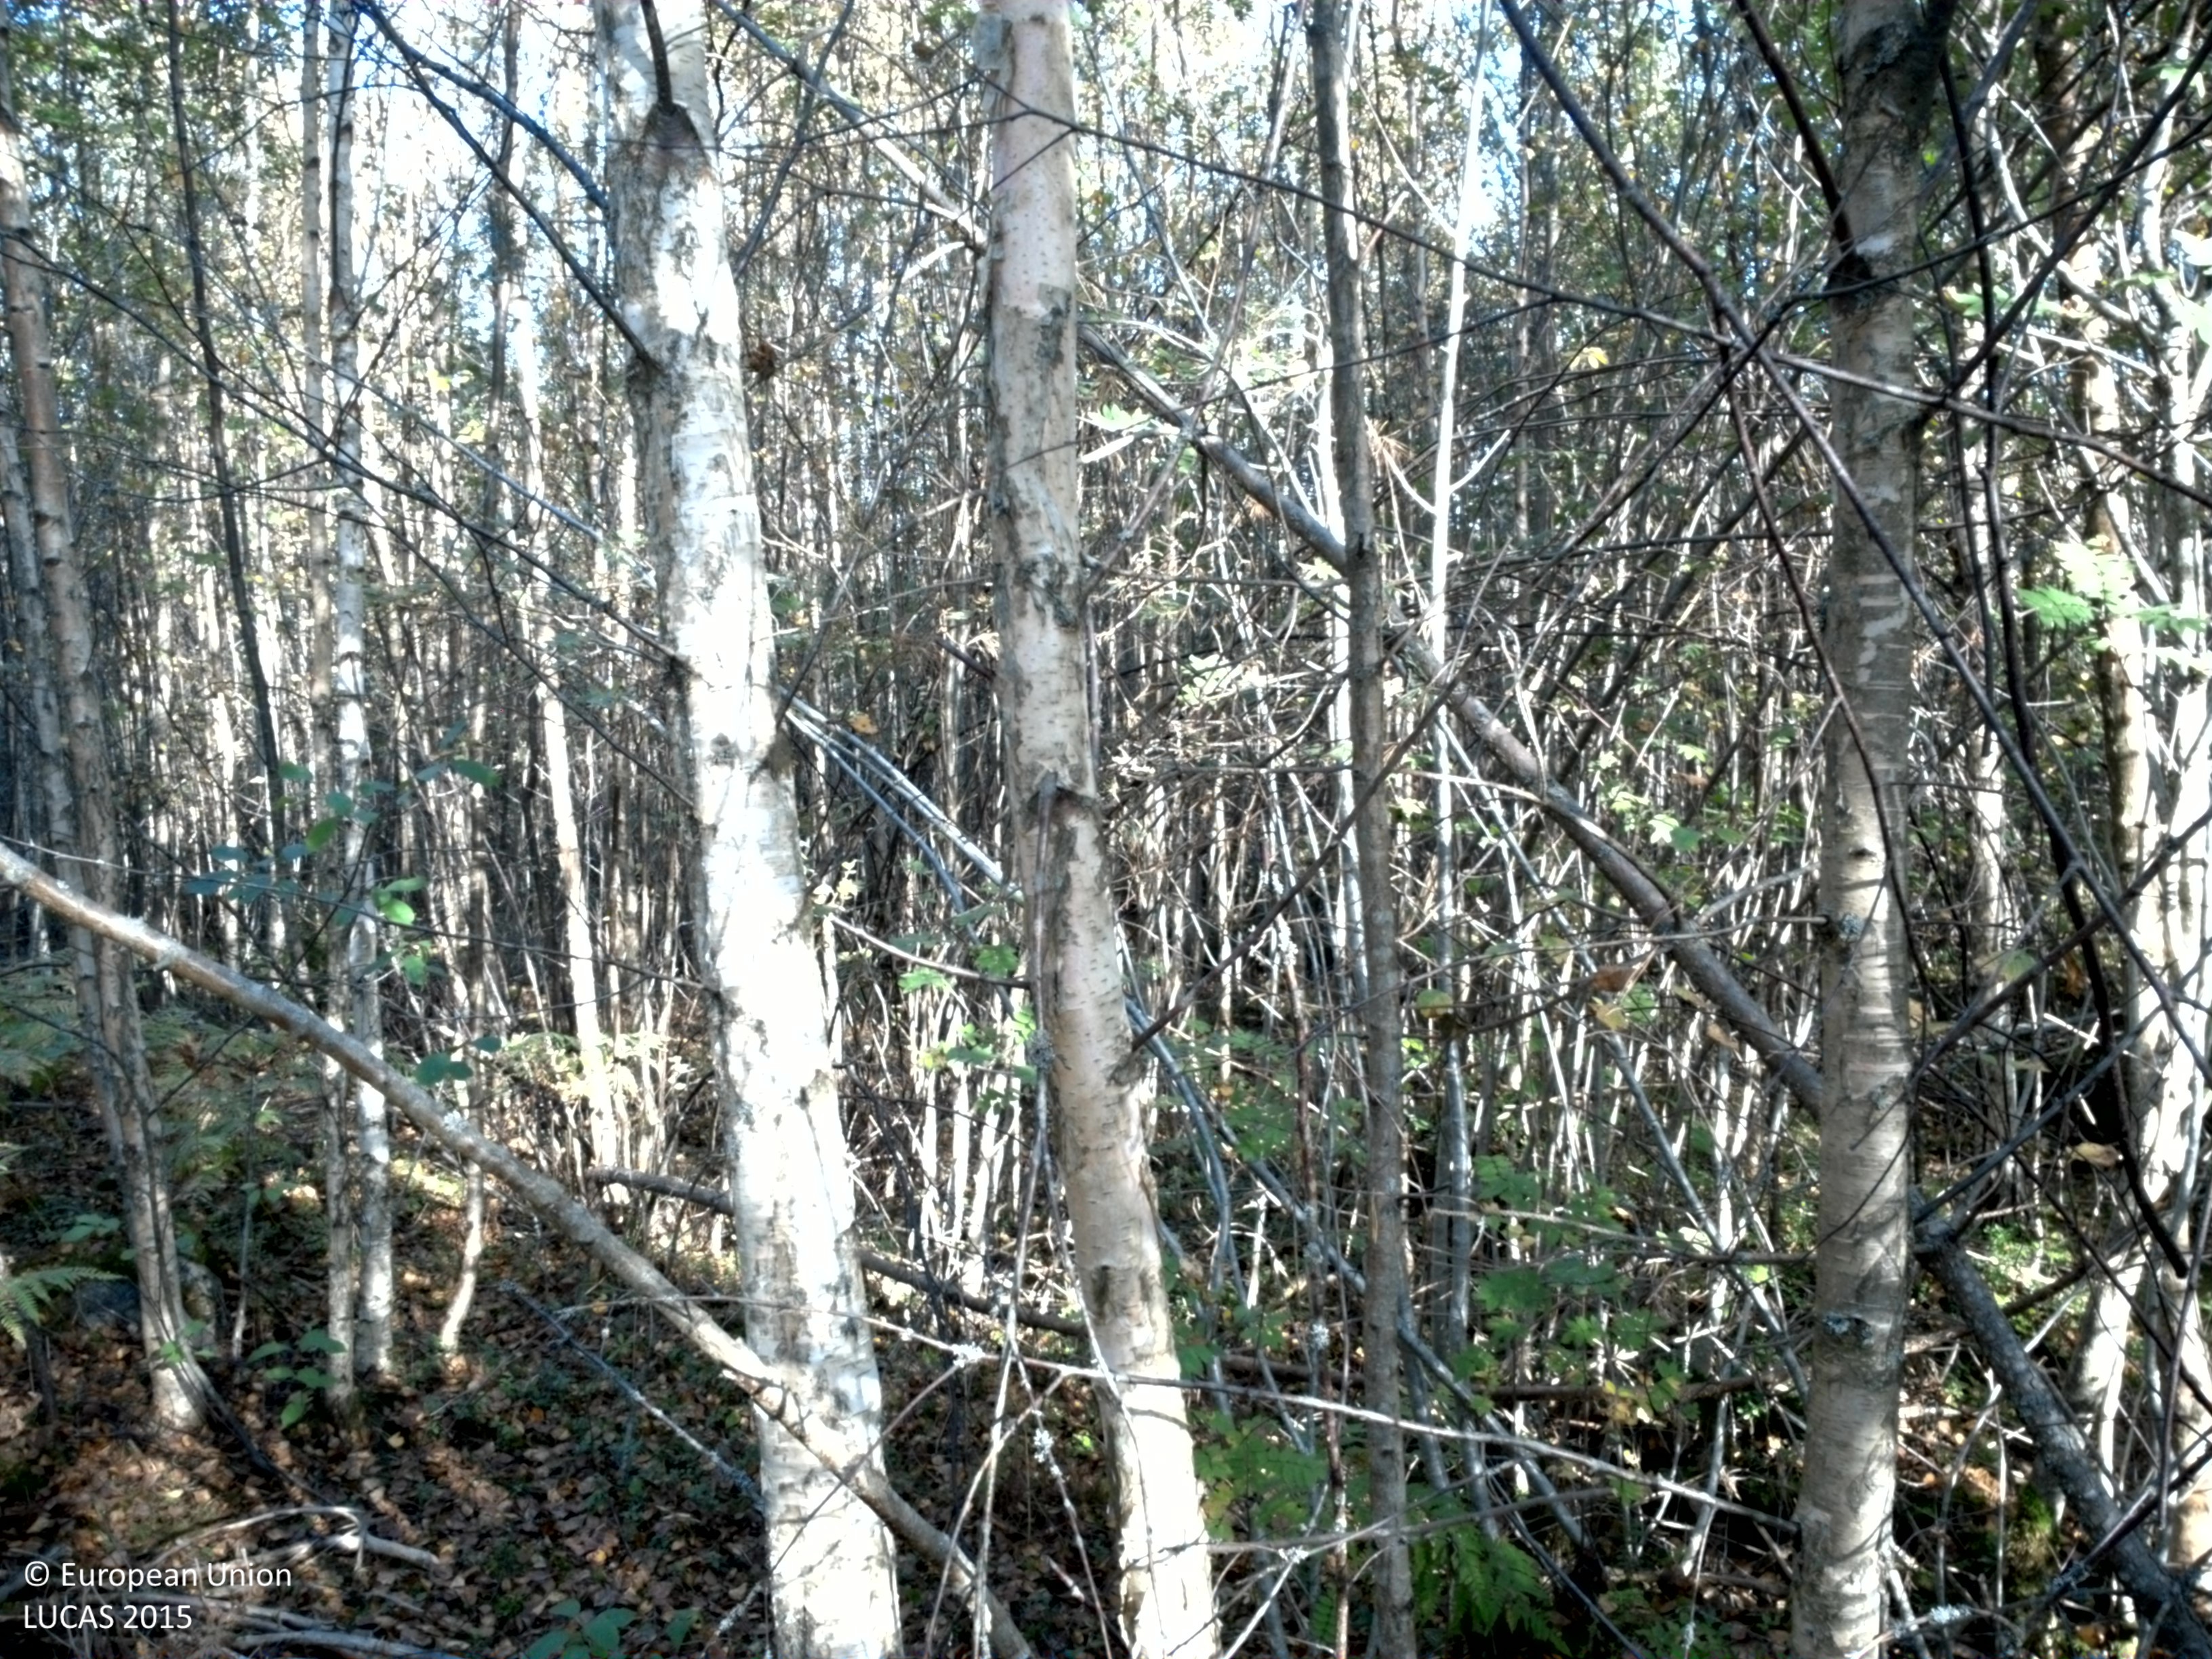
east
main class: Woodland
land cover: Broadleaved woodland
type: boreal forest
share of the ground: > 75 %
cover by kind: broadleaved forest trees 75 %, herbaceous plants 15 %, coniferous forest trees 10 %
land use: Forestry
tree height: > 5 m
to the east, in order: Broadleaved woodland; Fences; Ditches and canals; Broadleaved woodland; Grassland without tree/shrub cover; Spruce dominated coniferous woodland; Grassland without tree/shrub cover; Broadleaved woodland; Grassland without tree/shrub cover; Artificial constructions in urban areas
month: September
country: SE
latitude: 59.8019
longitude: 18.7157
